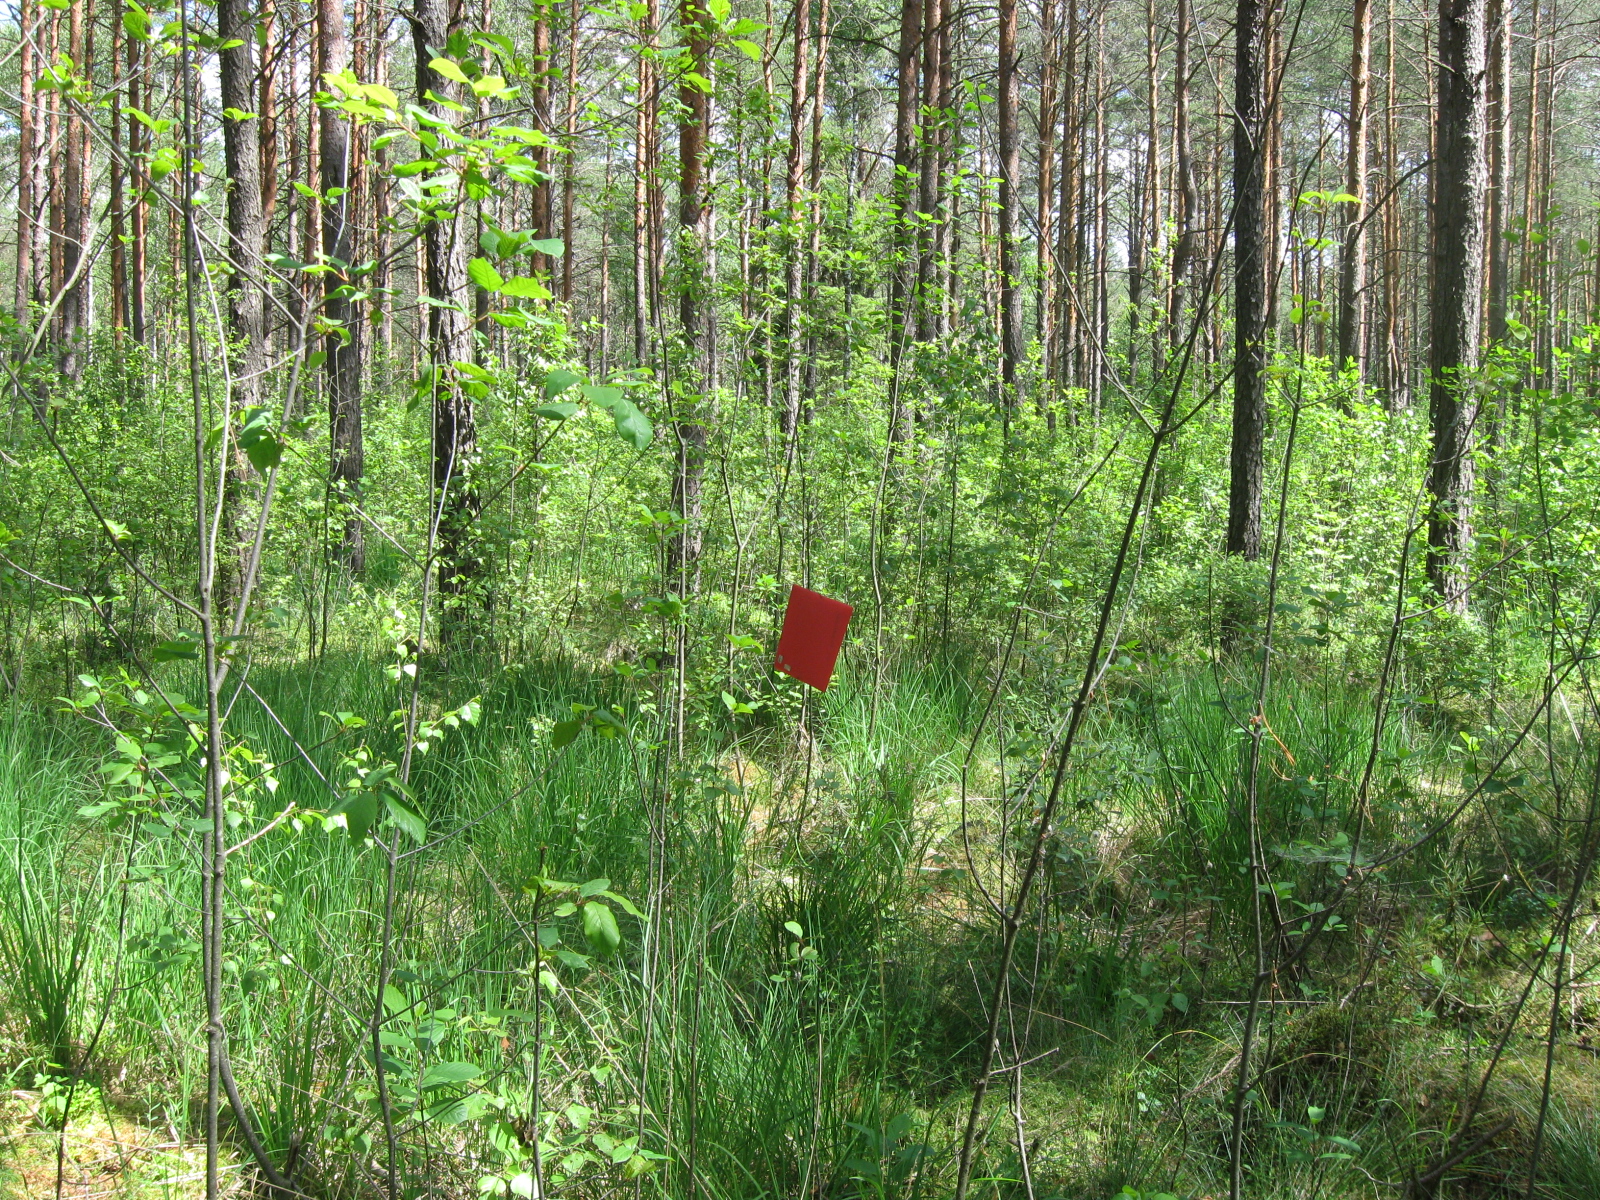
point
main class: Woodland
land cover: Pine dominated mixed woodland
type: mire and swamp forests
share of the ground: > 75 %
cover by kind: coniferous forest trees 55 %, broadleaved forest trees 30 %, herbaceous plants 15 %
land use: Forestry
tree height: > 5 m
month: June
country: LT
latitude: 53.9807
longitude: 24.2336
